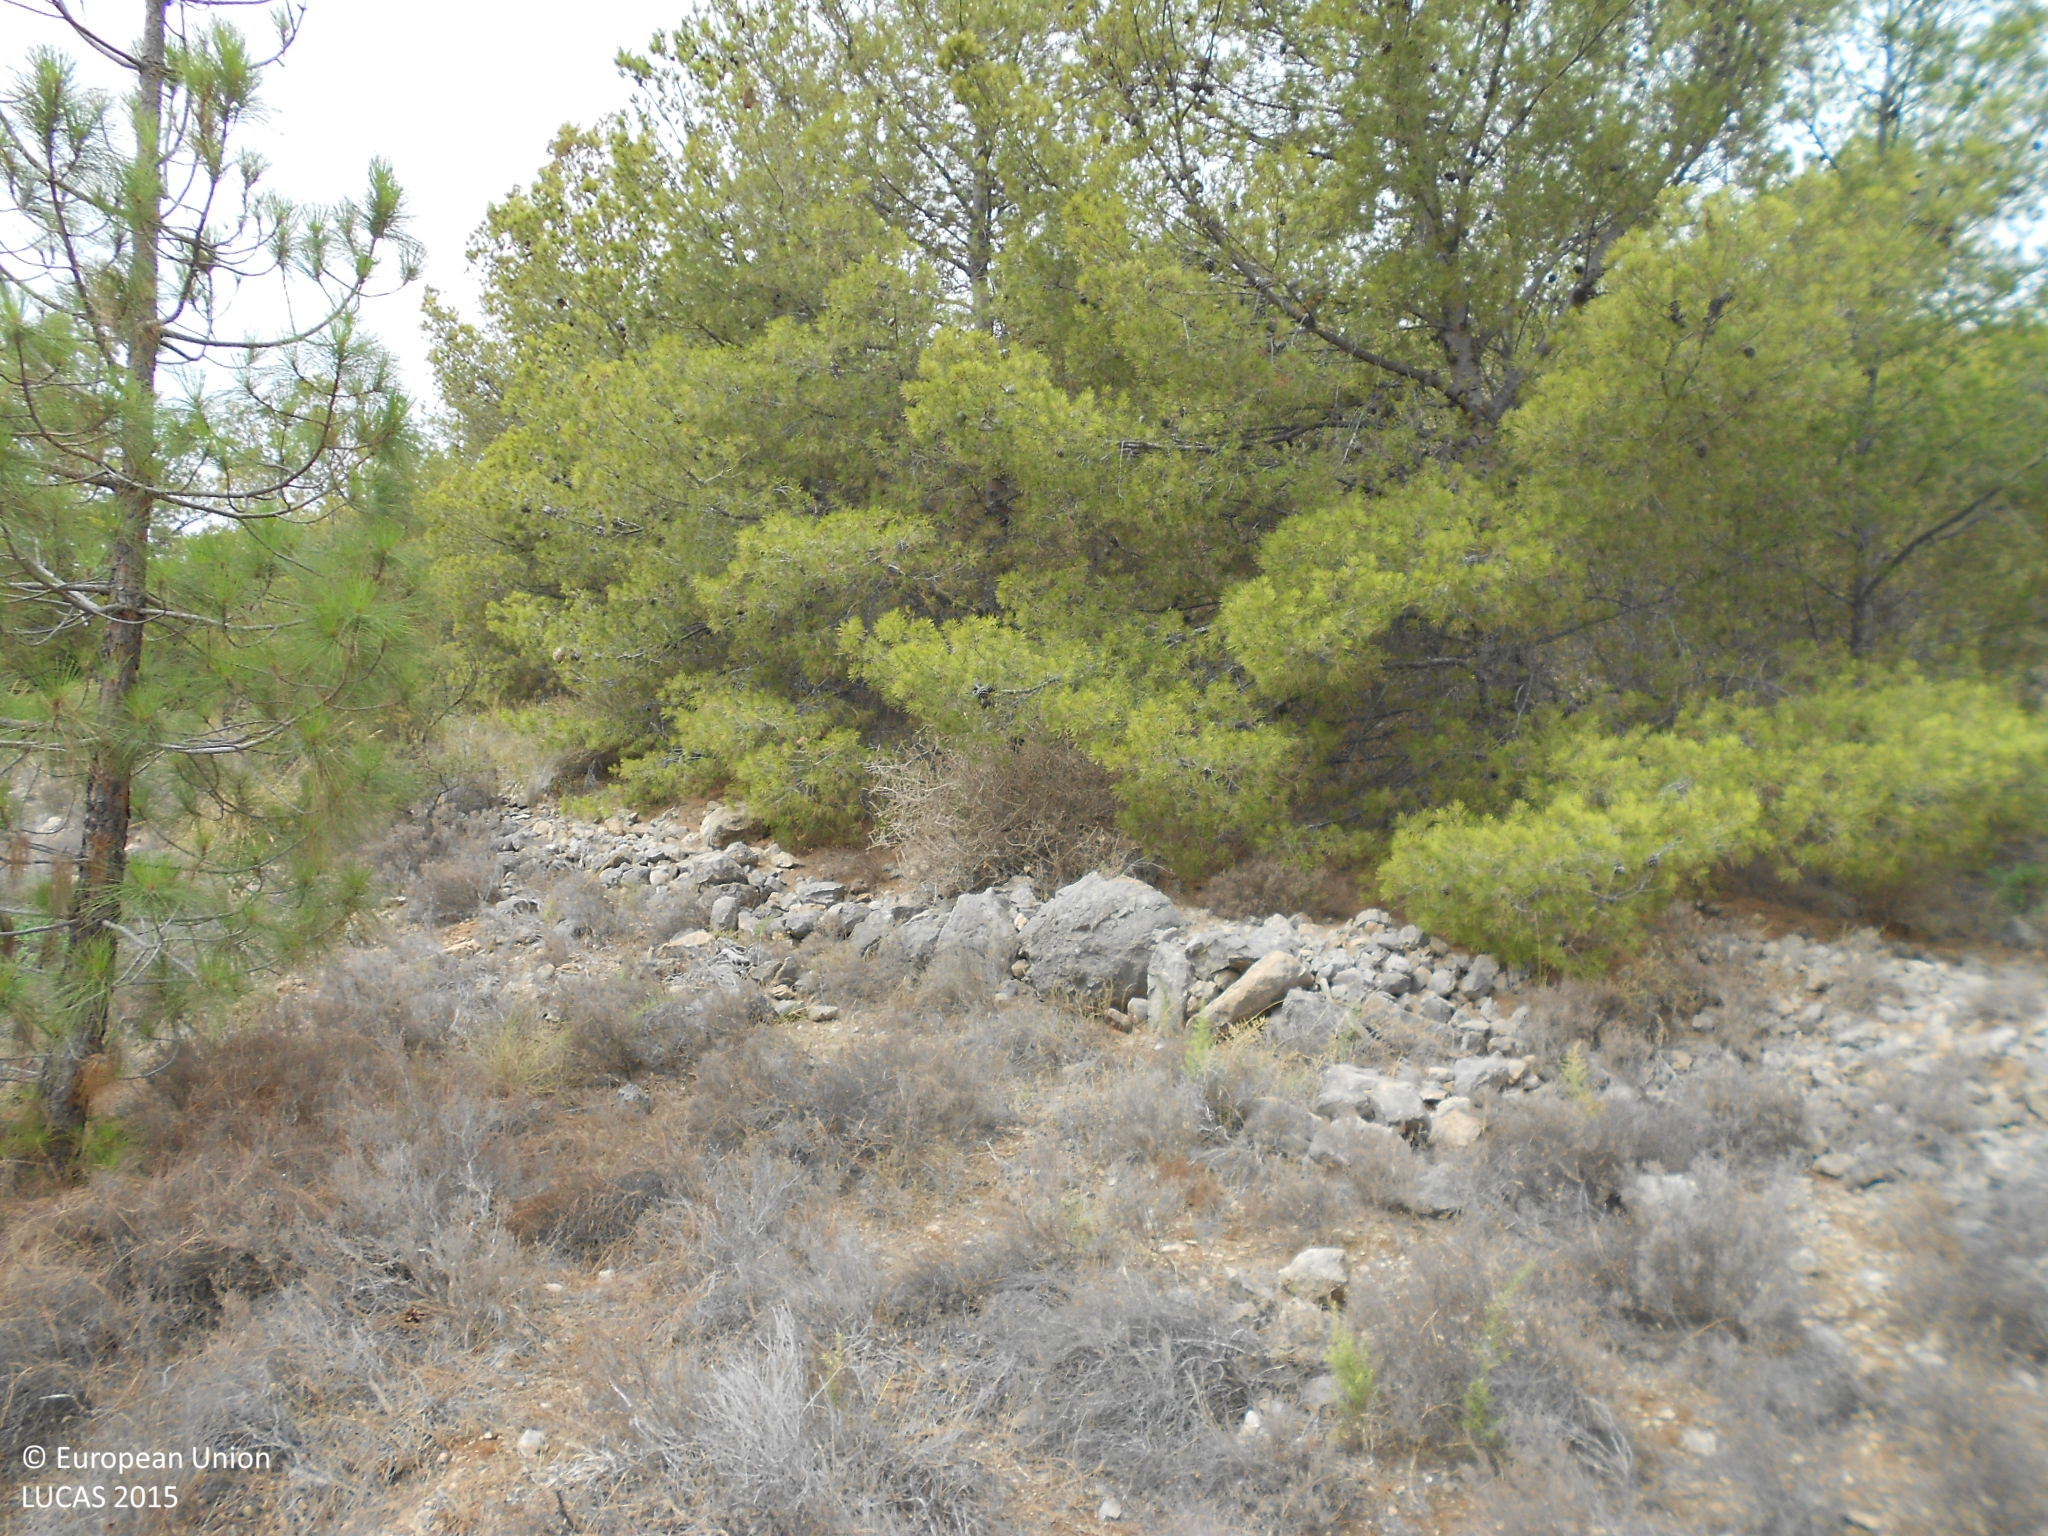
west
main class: Woodland
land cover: Pine dominated coniferous woodland
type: coniferous forest of the mediterranean region
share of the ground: 10 - 25 %
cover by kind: shrubs 40 %, herbaceous plants 40 %, coniferous forest trees 15 %, consolidated bare surface 5 %
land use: Forestry
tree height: > 5 m
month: August
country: ES
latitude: 36.8159
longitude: -2.7223
